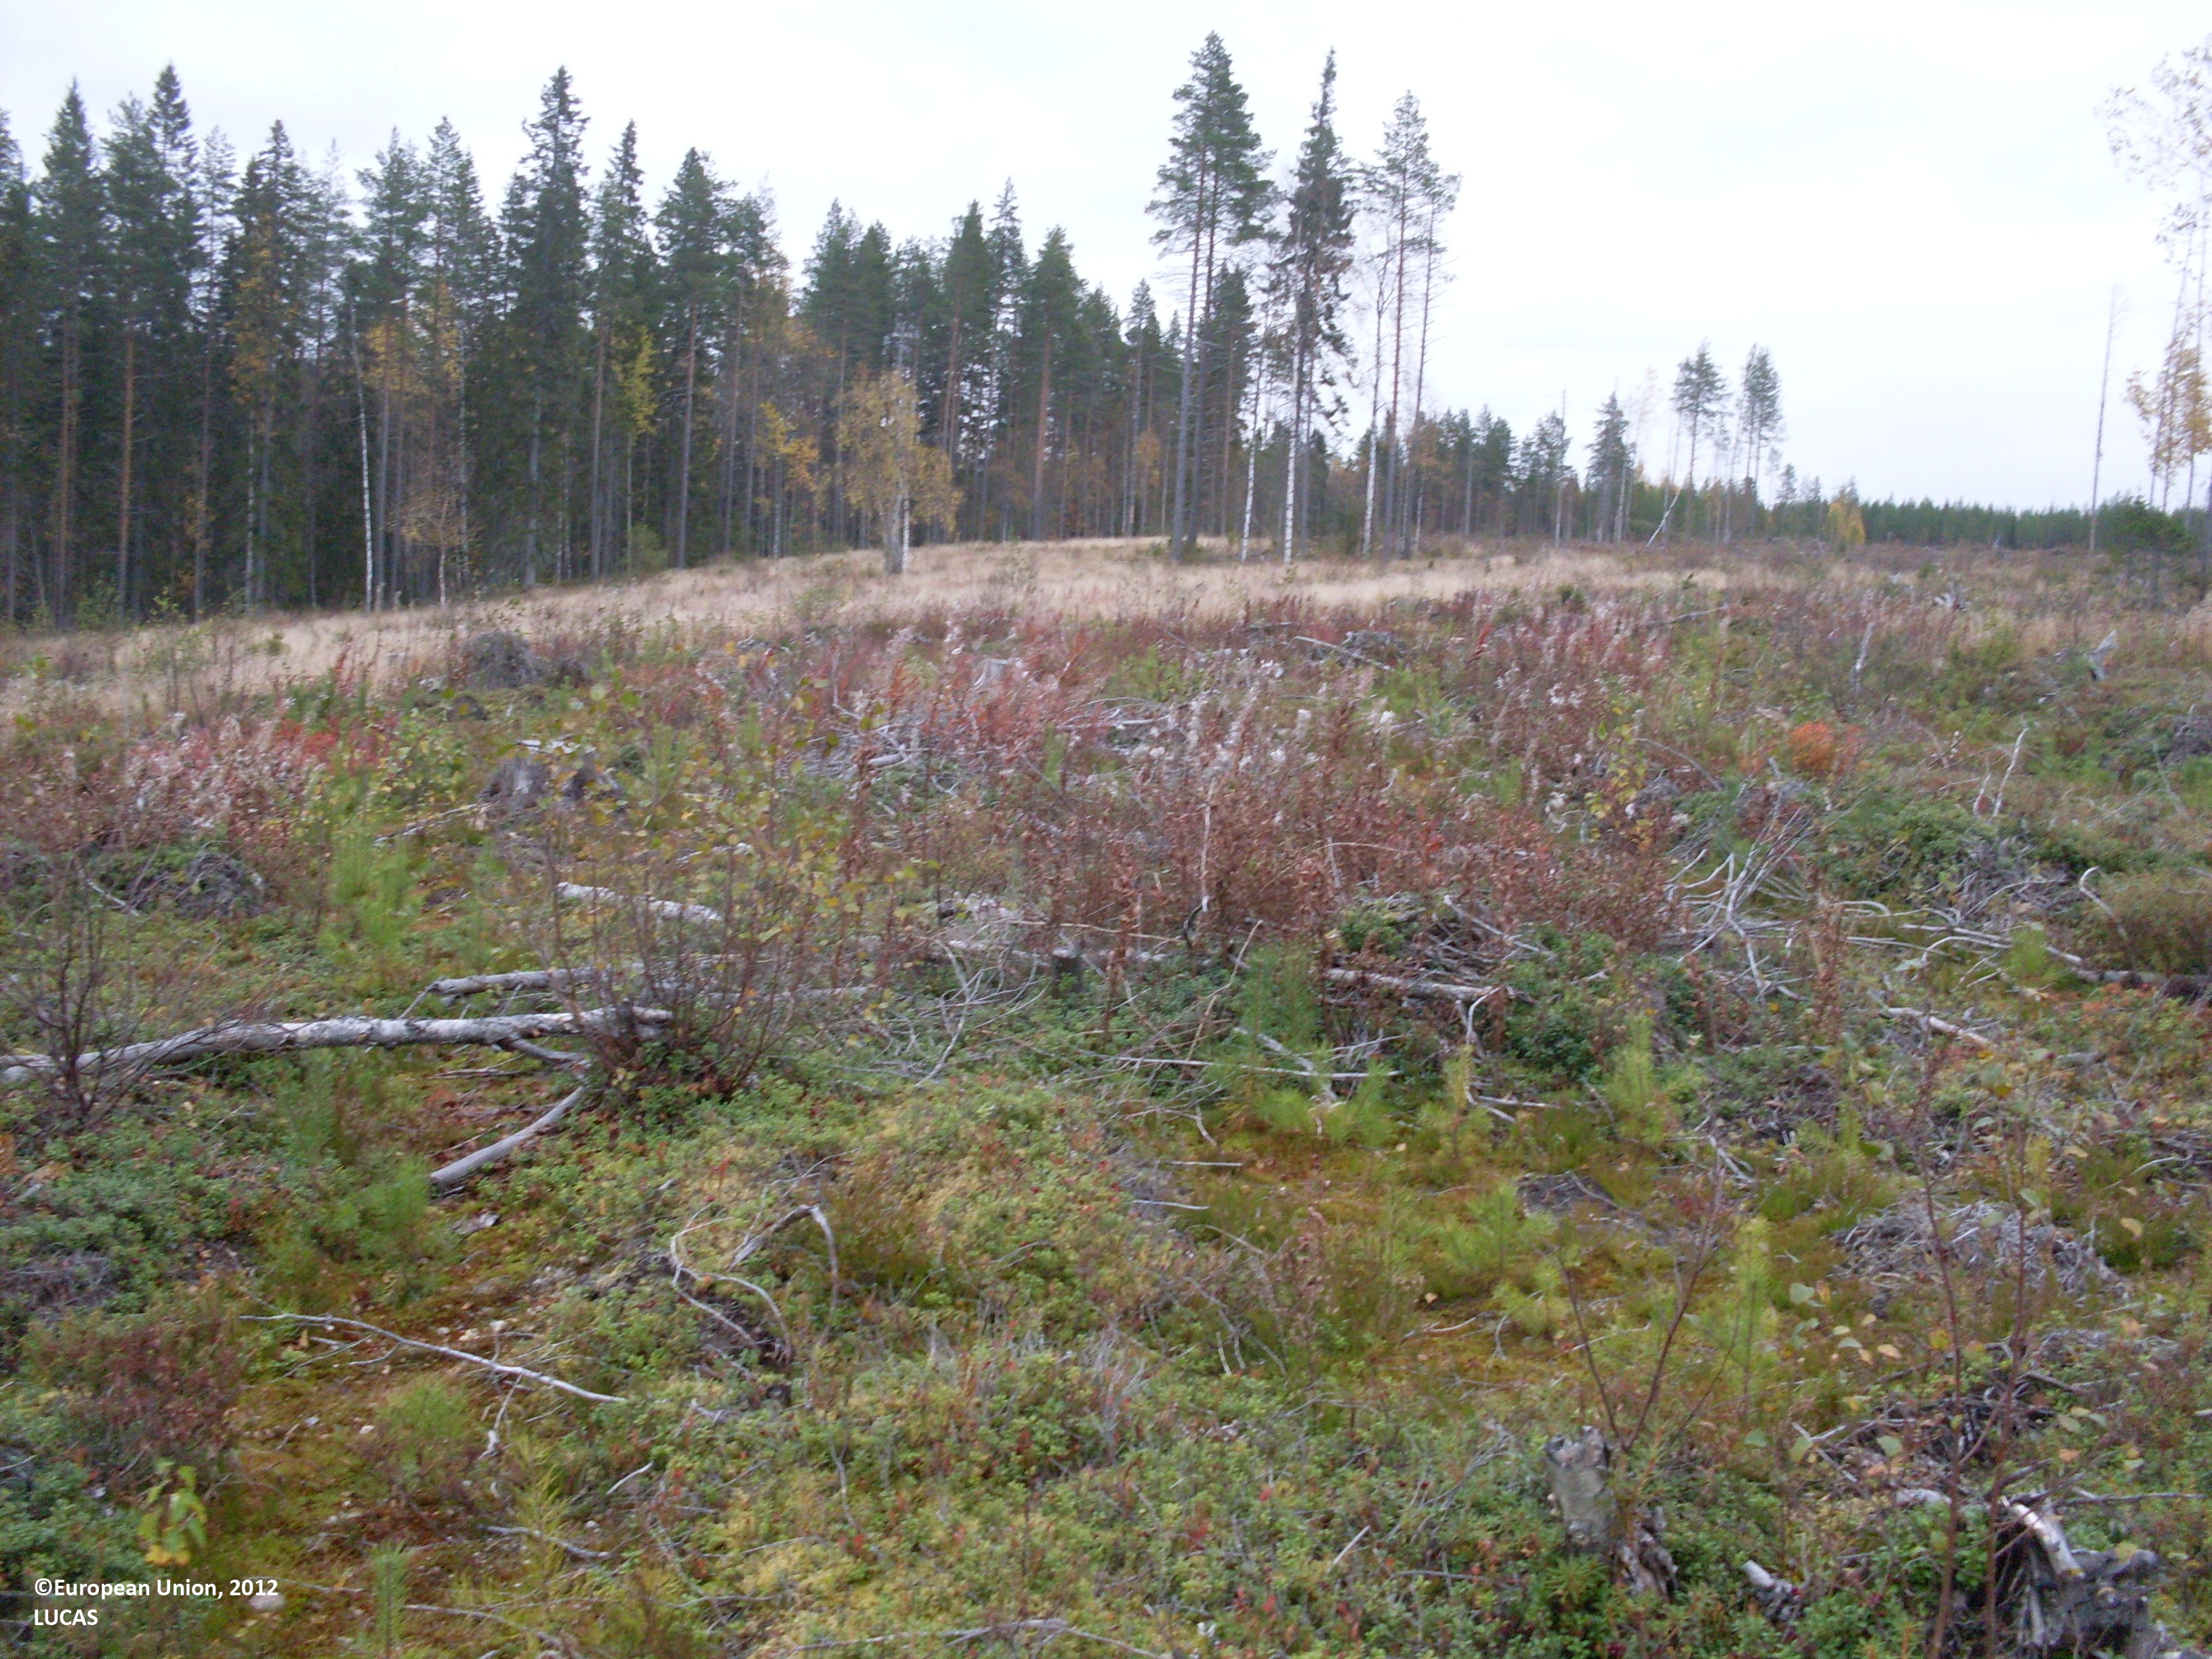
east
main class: Shrubland
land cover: Shrubland with sparse tree cover
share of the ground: > 75 %
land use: Forestry
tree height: < 5 m
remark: Clear cut
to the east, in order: Shrubland with sparse tree cover
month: September
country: FI
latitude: 64.2601
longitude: 29.9010
